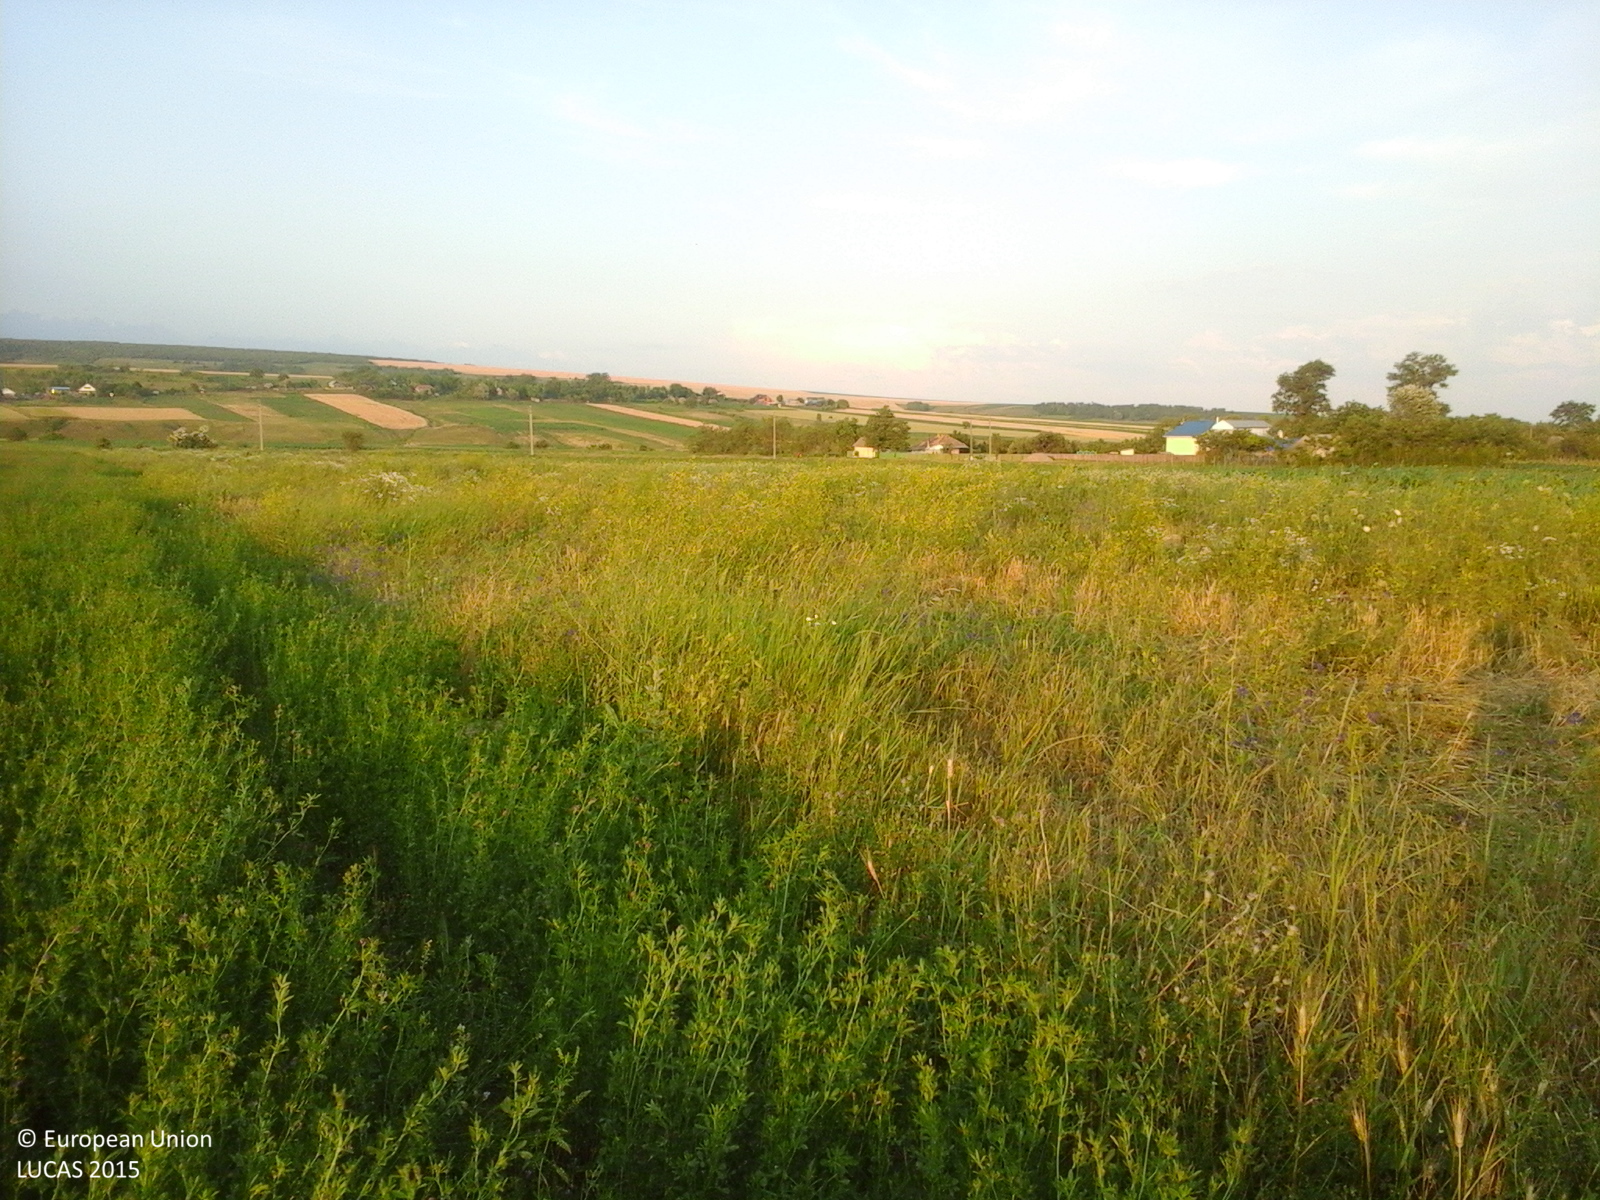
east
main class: Cropland
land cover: Lucerne
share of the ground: > 75 %
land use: Agriculture (excluding fallow land and kitchen gardens)
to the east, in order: Lucerne; Grassland without tree/shrub cover; Other fresh vegetables; Soya
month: June
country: RO
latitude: 46.8644
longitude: 27.3865
